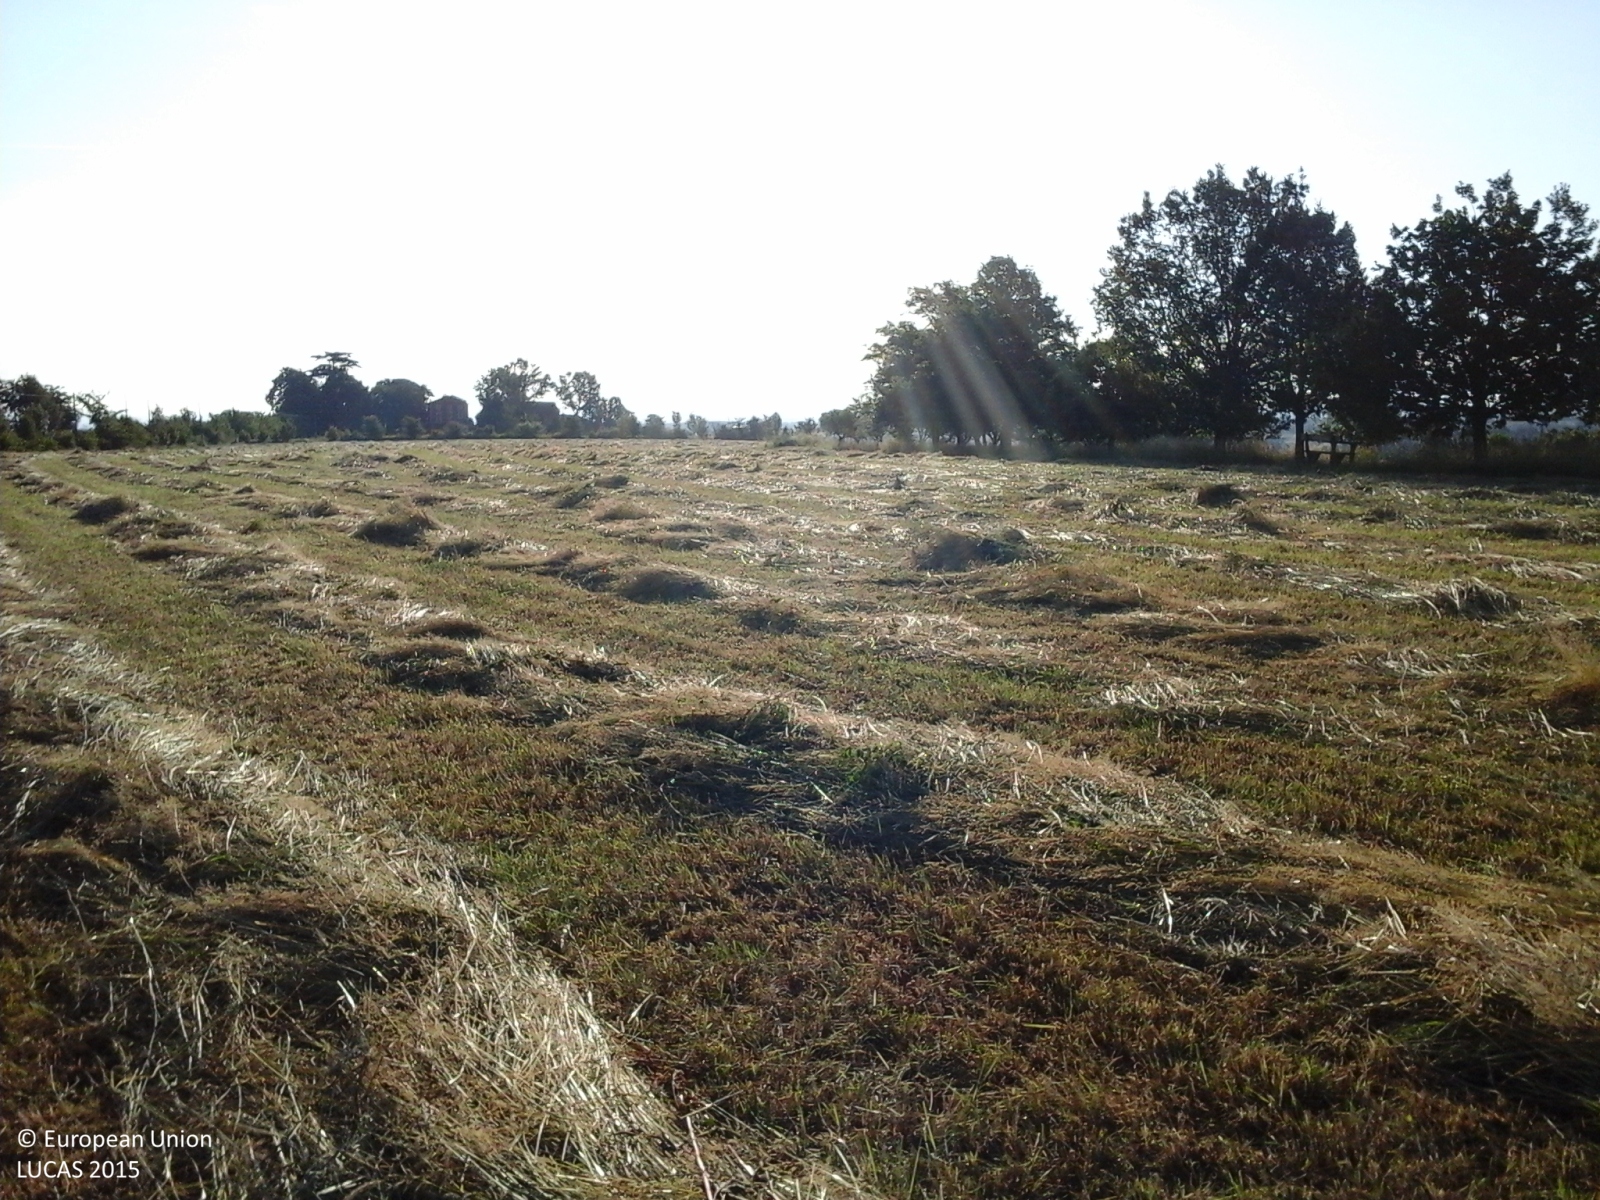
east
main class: Grassland
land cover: Grassland without tree/shrub cover
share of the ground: > 75 %
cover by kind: herbaceous plants 100 %
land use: Agriculture (excluding fallow land and kitchen gardens)
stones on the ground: < 10 %
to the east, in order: Grassland without tree/shrub cover; Lines of trees; Grassland without tree/shrub cover; Apple fruit; Grassland without tree/shrub cover; Fences; Spontaneously vegetated surfaces
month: May
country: IT
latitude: 44.8014
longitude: 10.0631
